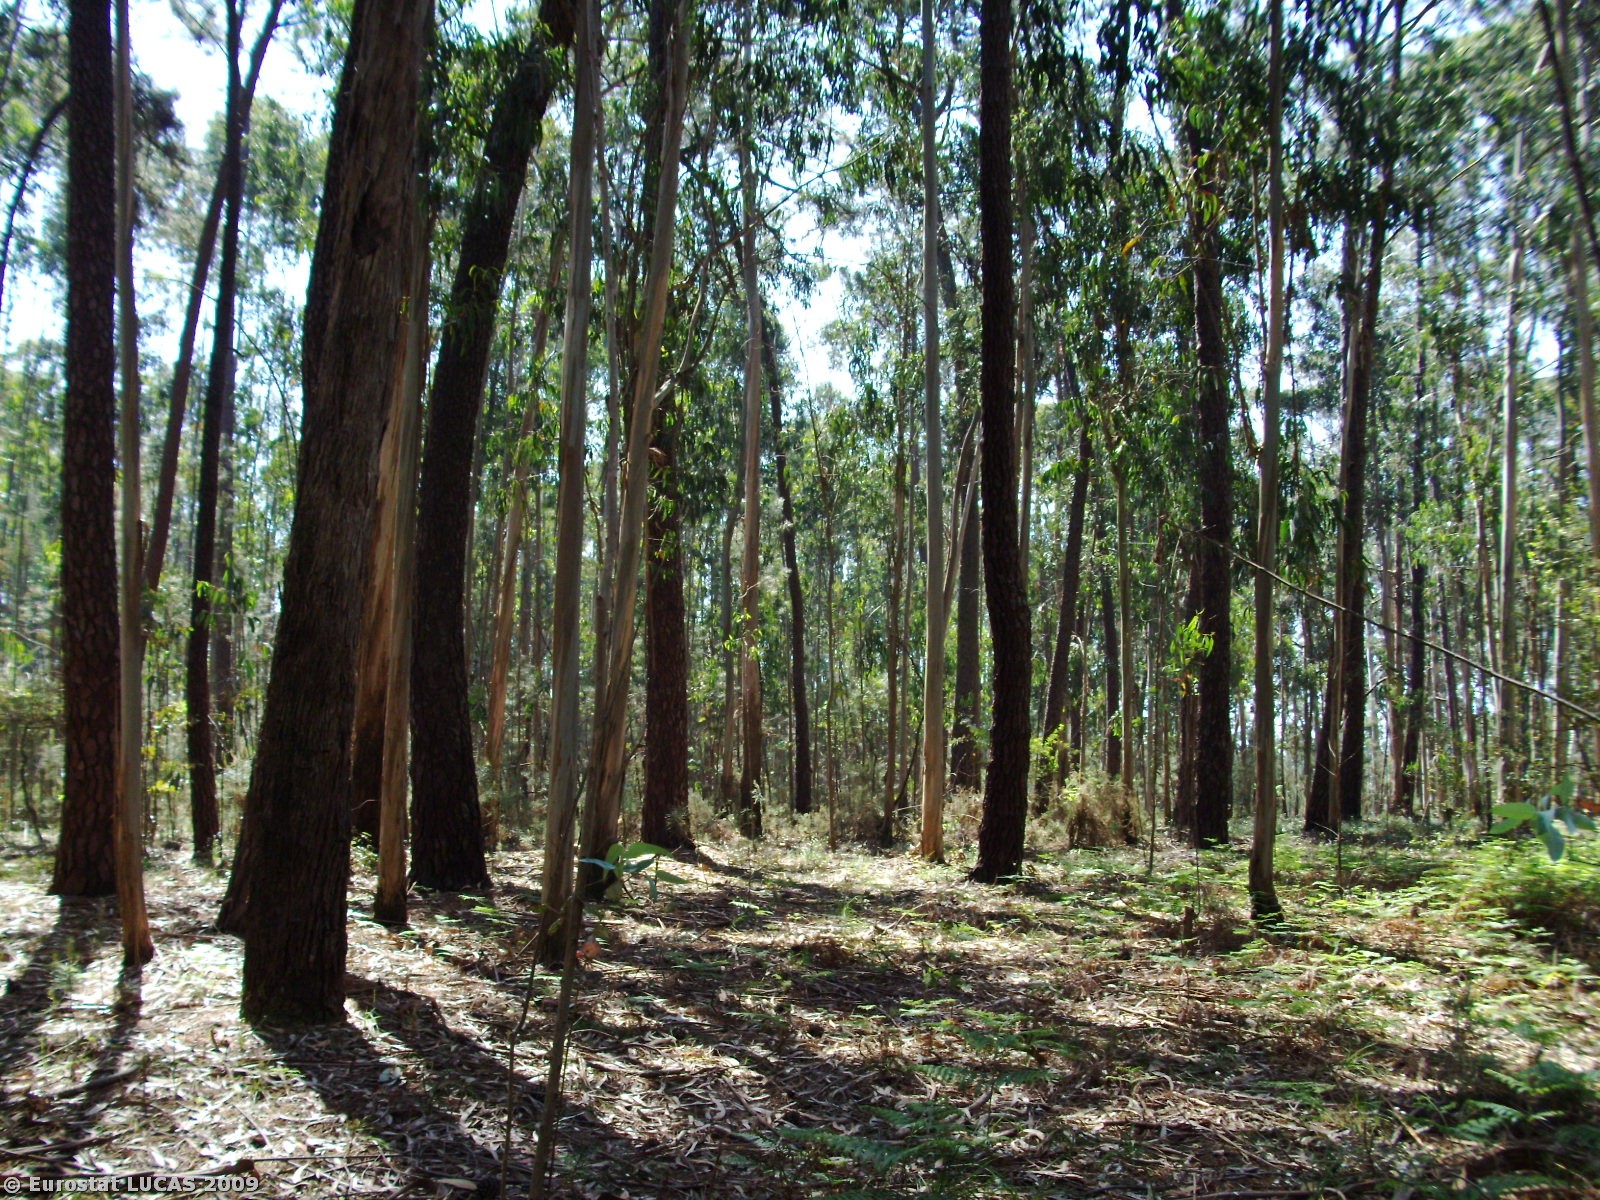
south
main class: Woodland
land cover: Mixed woodland
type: plantations and self-sown exotic forest
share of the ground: 50 - 75 %
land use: Forestry
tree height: > 5 m
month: May
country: PT
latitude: 40.7320
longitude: -8.4827
